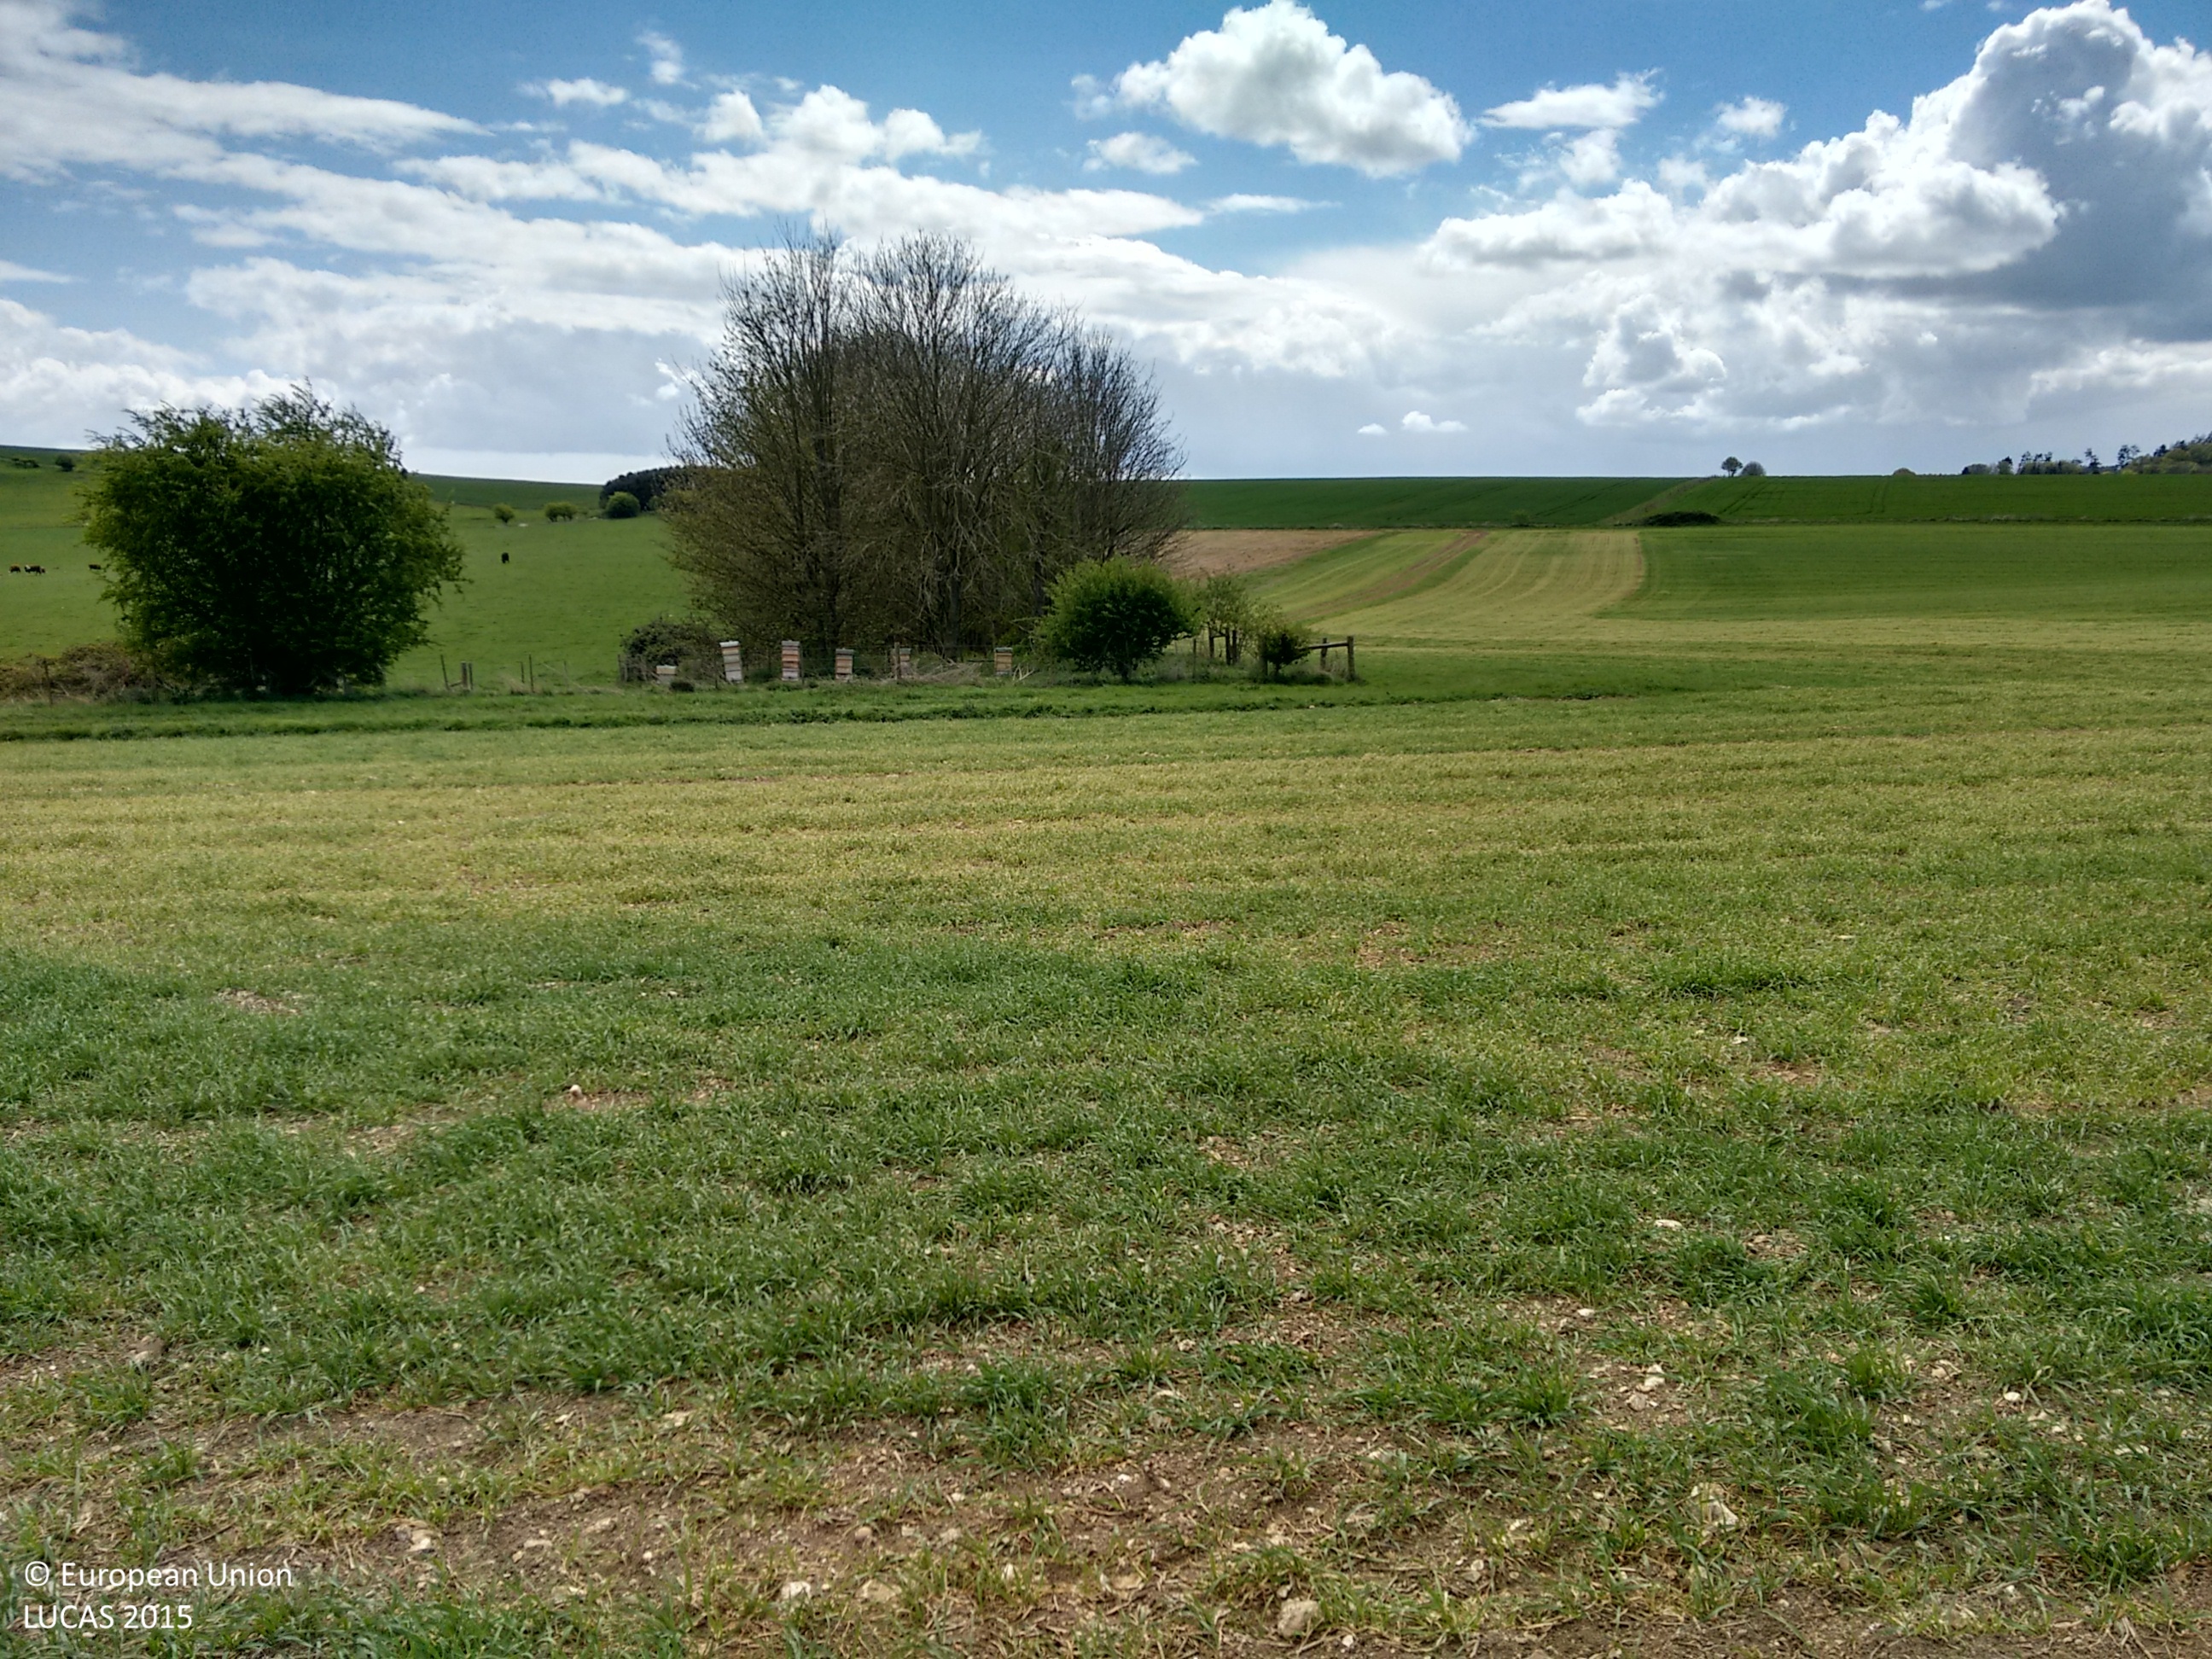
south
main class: Cropland
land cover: Barley
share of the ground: 50 - 75 %
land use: Agriculture (excluding fallow land and kitchen gardens)
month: April
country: GB
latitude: 50.9595
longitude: -1.8878
